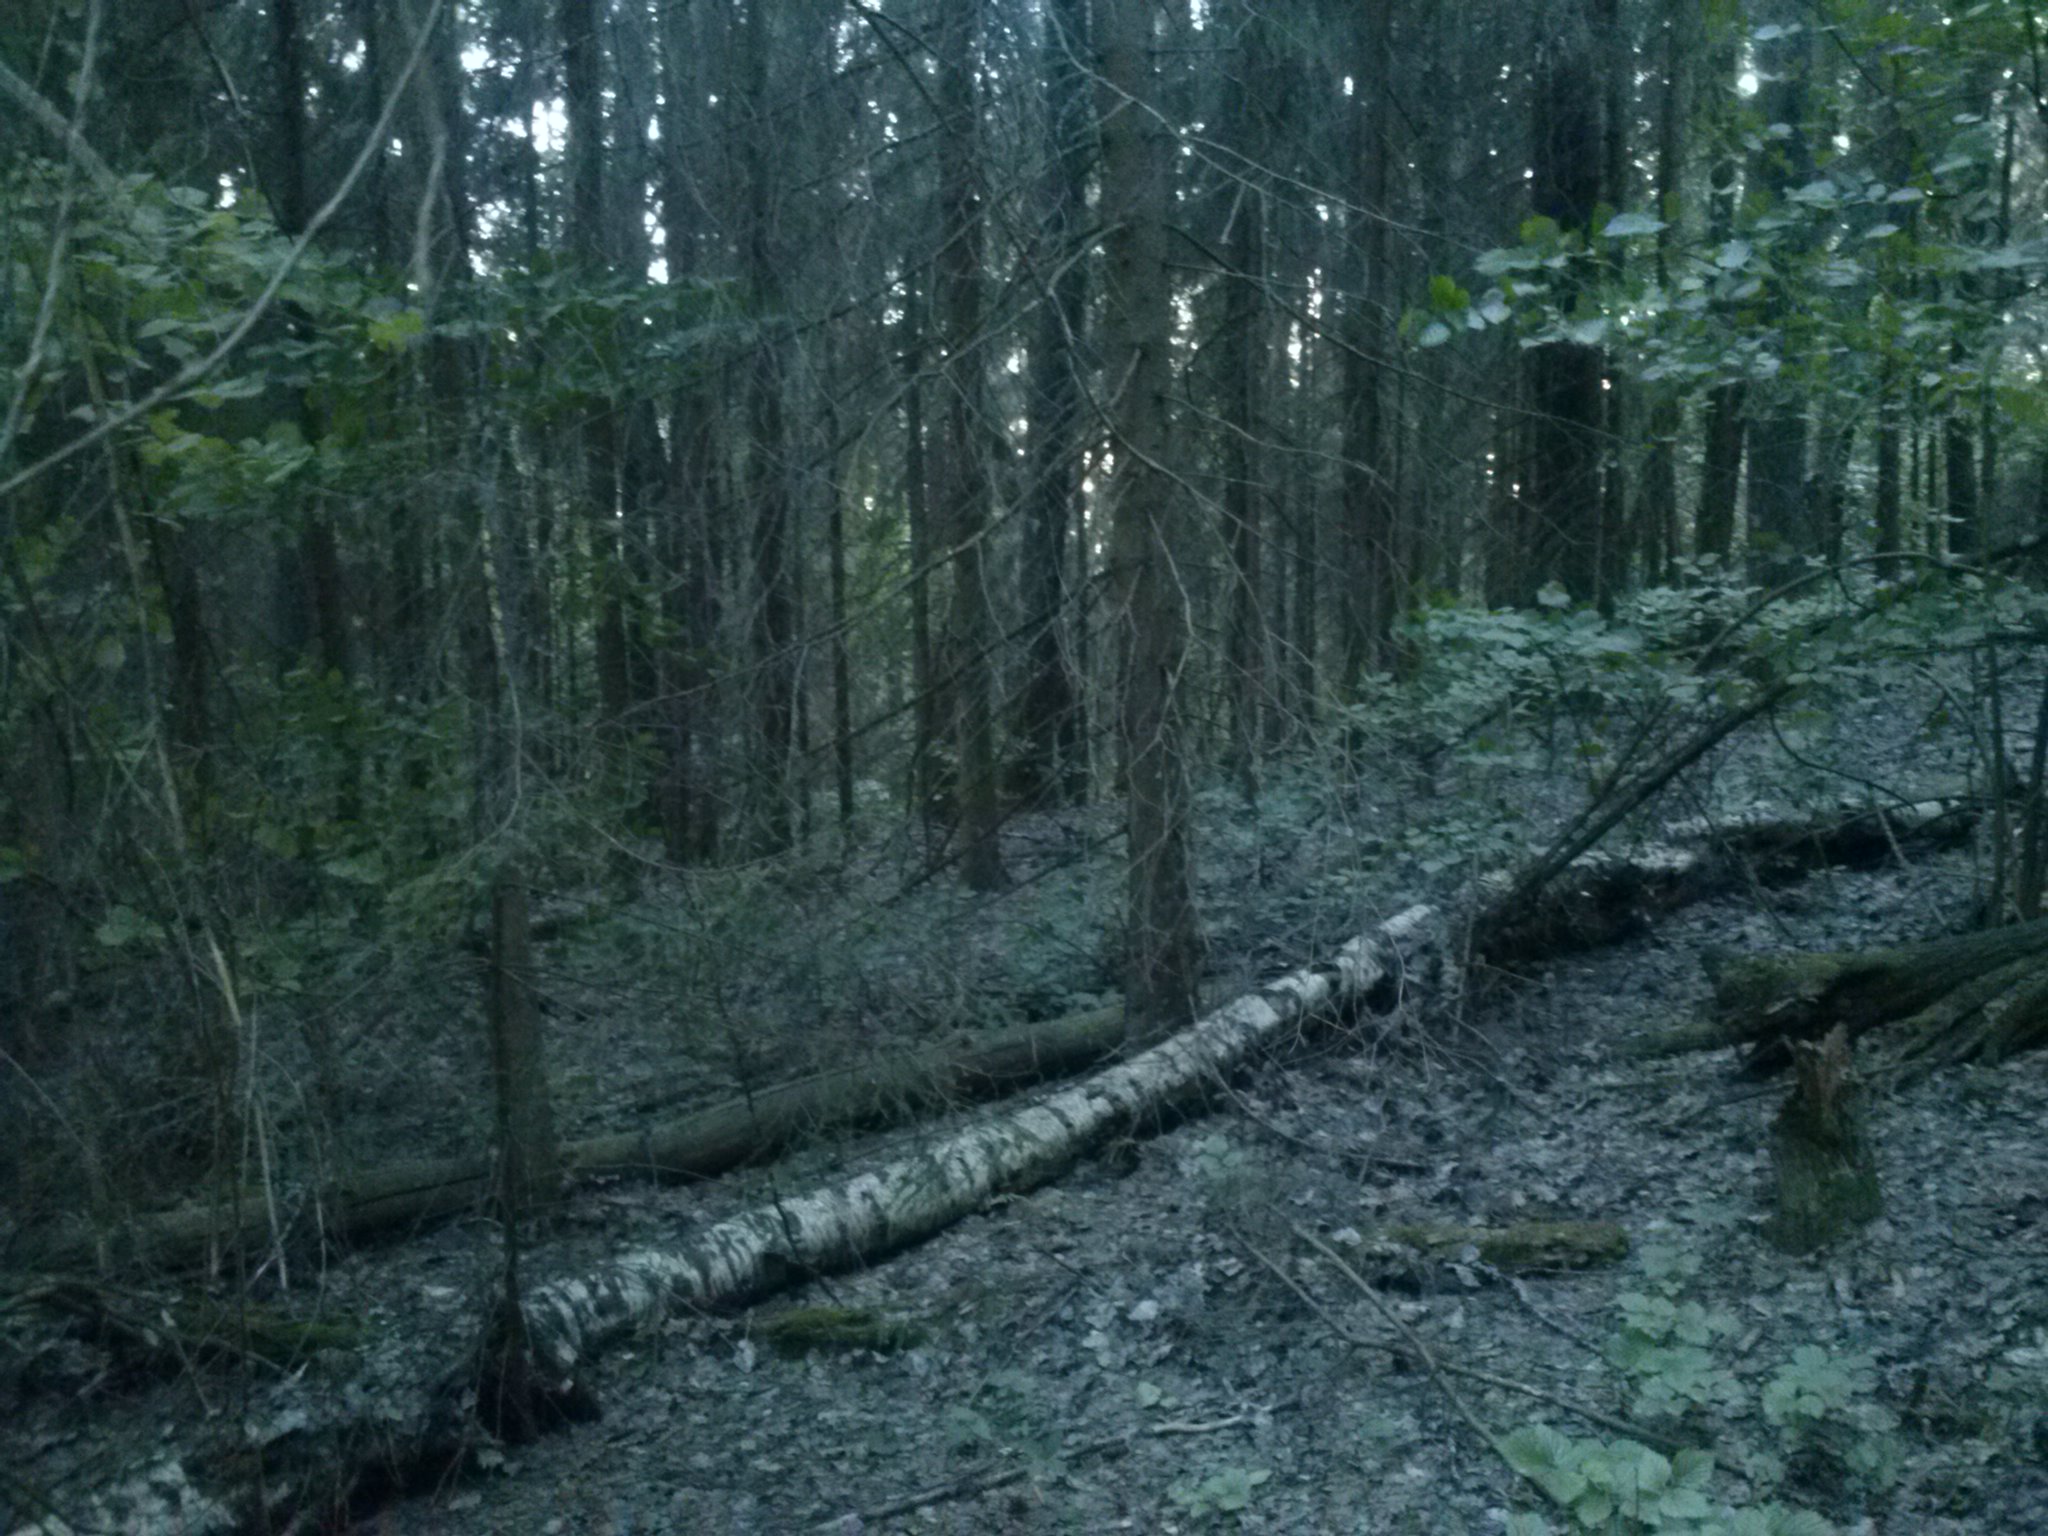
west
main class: Woodland
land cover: Other coniferous woodland
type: hemiboreal forest and nemoral coniferous forest and mixed broadleaved-coniferous forest
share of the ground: > 75 %
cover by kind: coniferous forest trees 75 %, broadleaved forest trees 25 %
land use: Forestry
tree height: > 5 m
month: June
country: LV
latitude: 56.3830
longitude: 27.8278
